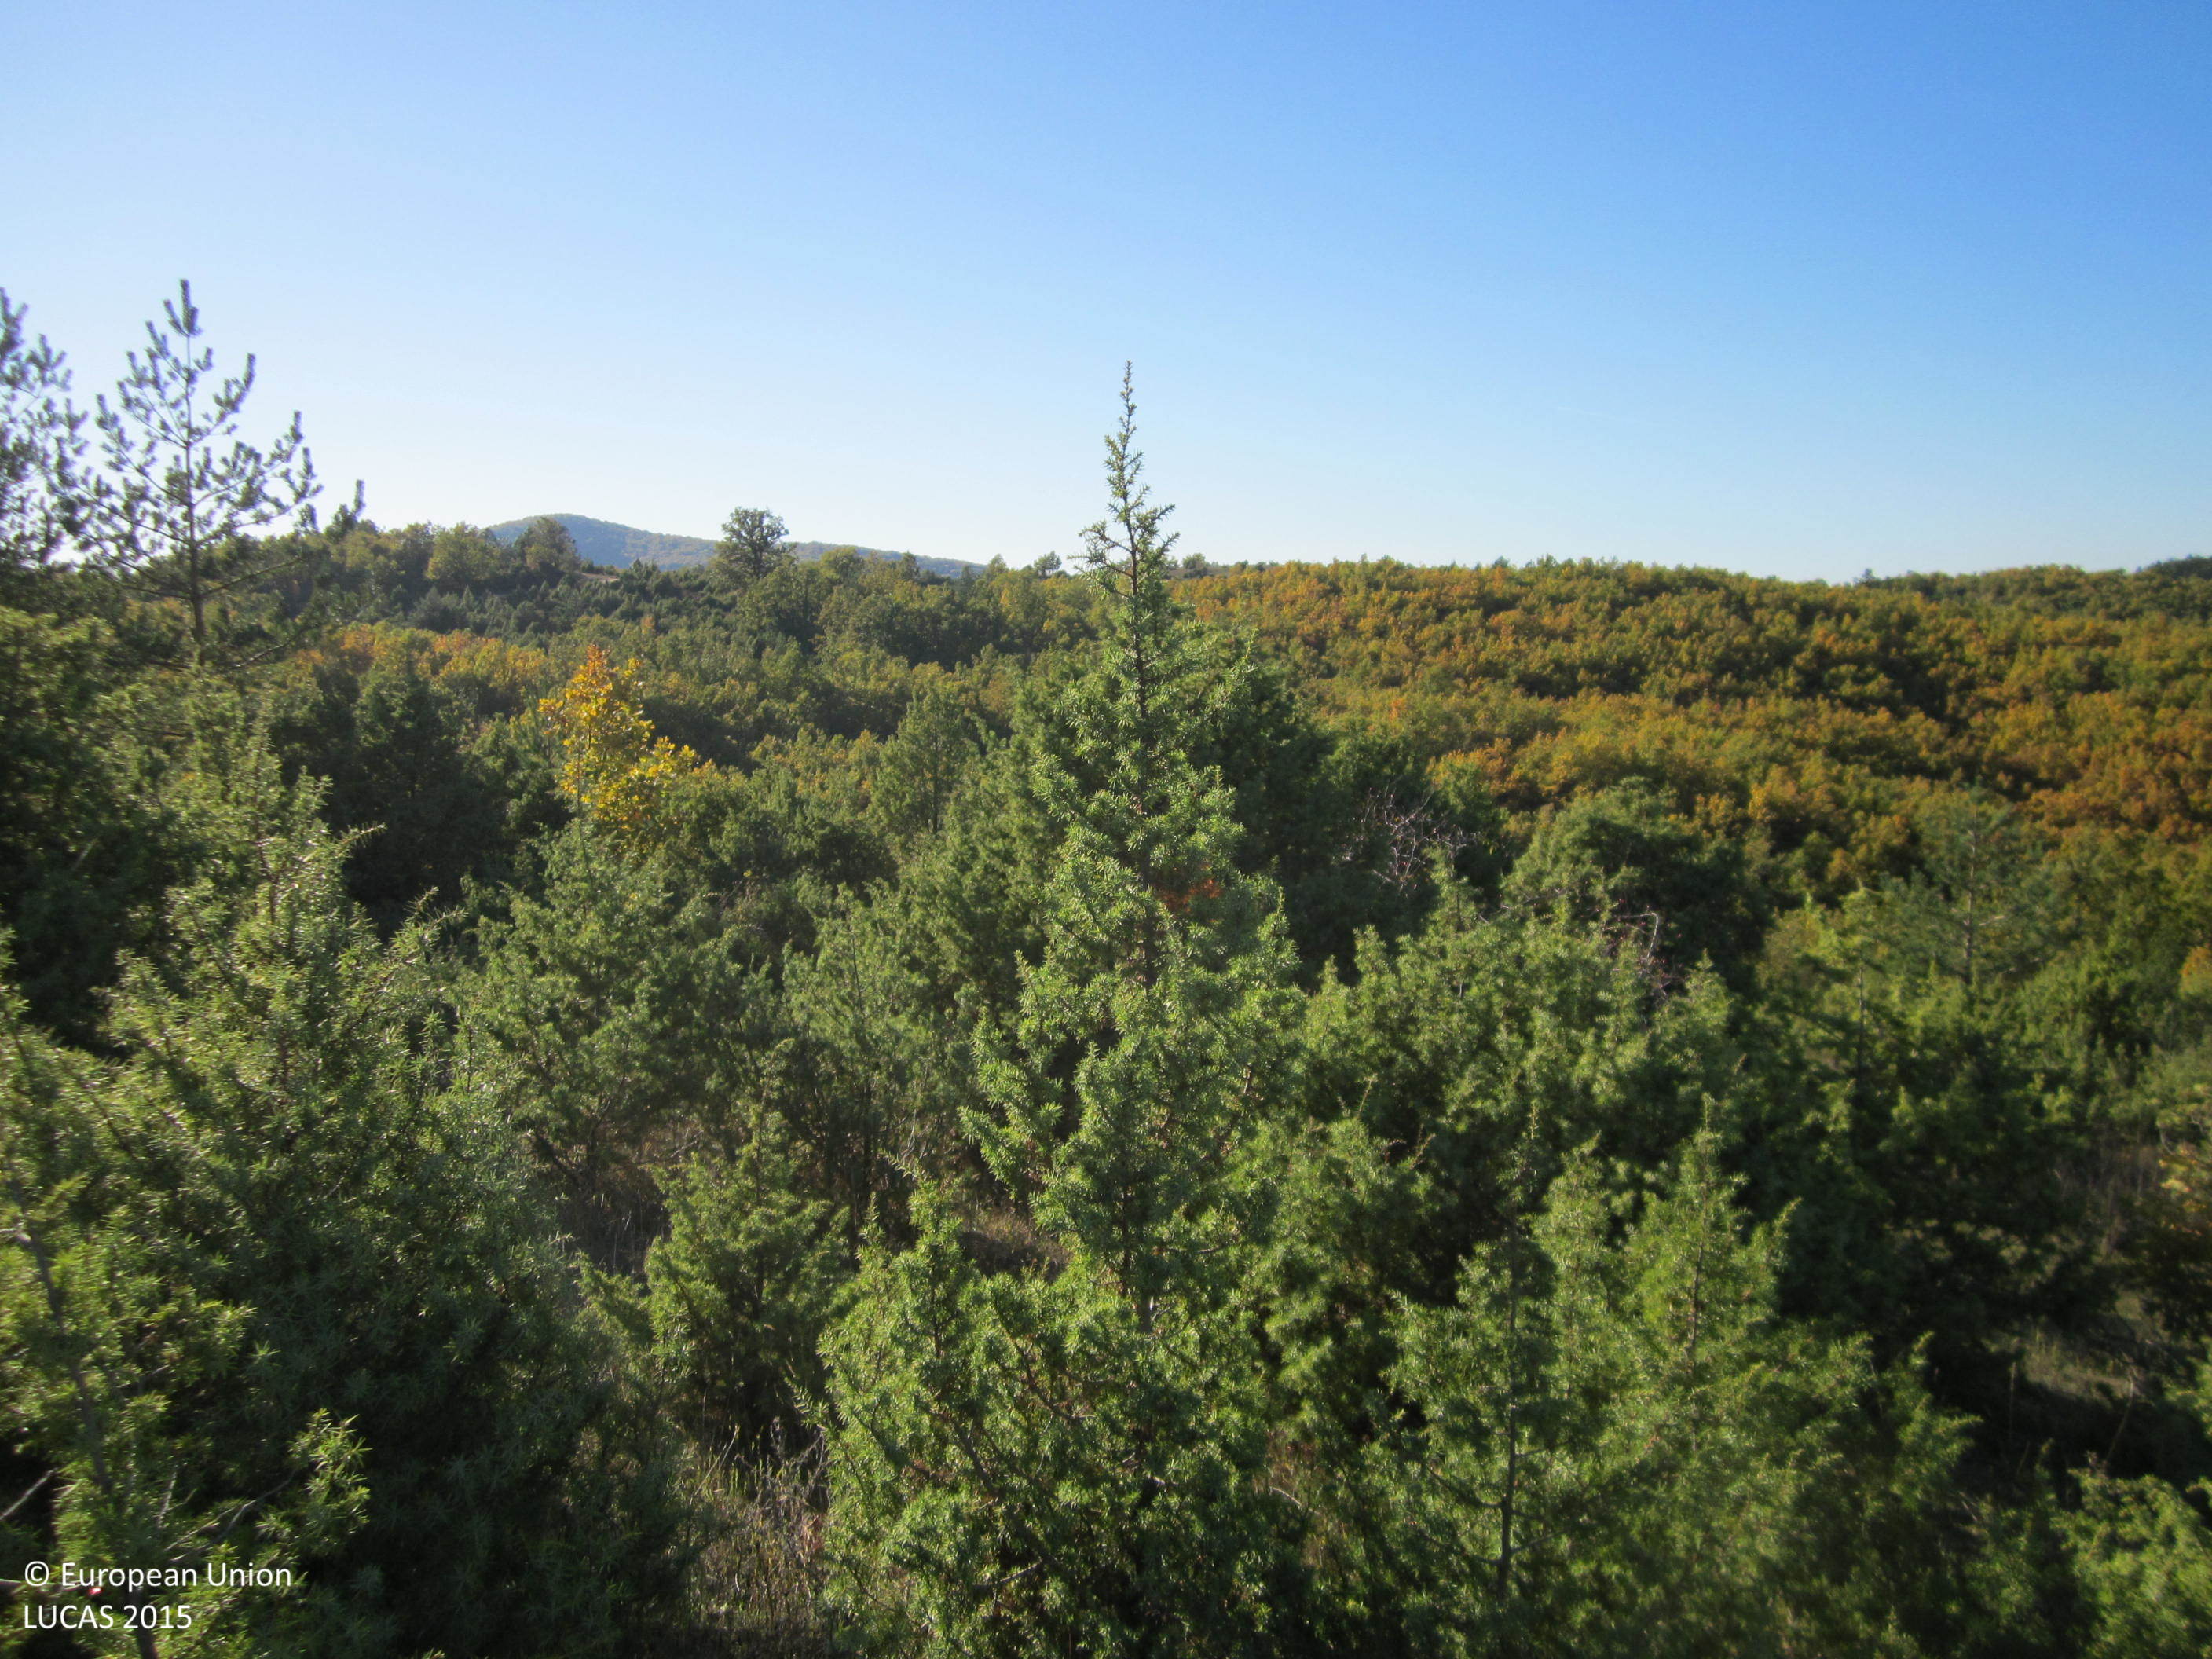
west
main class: Woodland
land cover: Other coniferous woodland
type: hemiboreal forest and nemoral coniferous forest and mixed broadleaved-coniferous forest
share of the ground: 50 - 75 %
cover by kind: coniferous forest trees 60 %, herbaceous plants 35 %, broadleaved forest trees 5 %
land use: Agriculture (excluding fallow land and kitchen gardens)
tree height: < 5 m
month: November
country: BG
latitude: 41.4135
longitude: 25.7455
